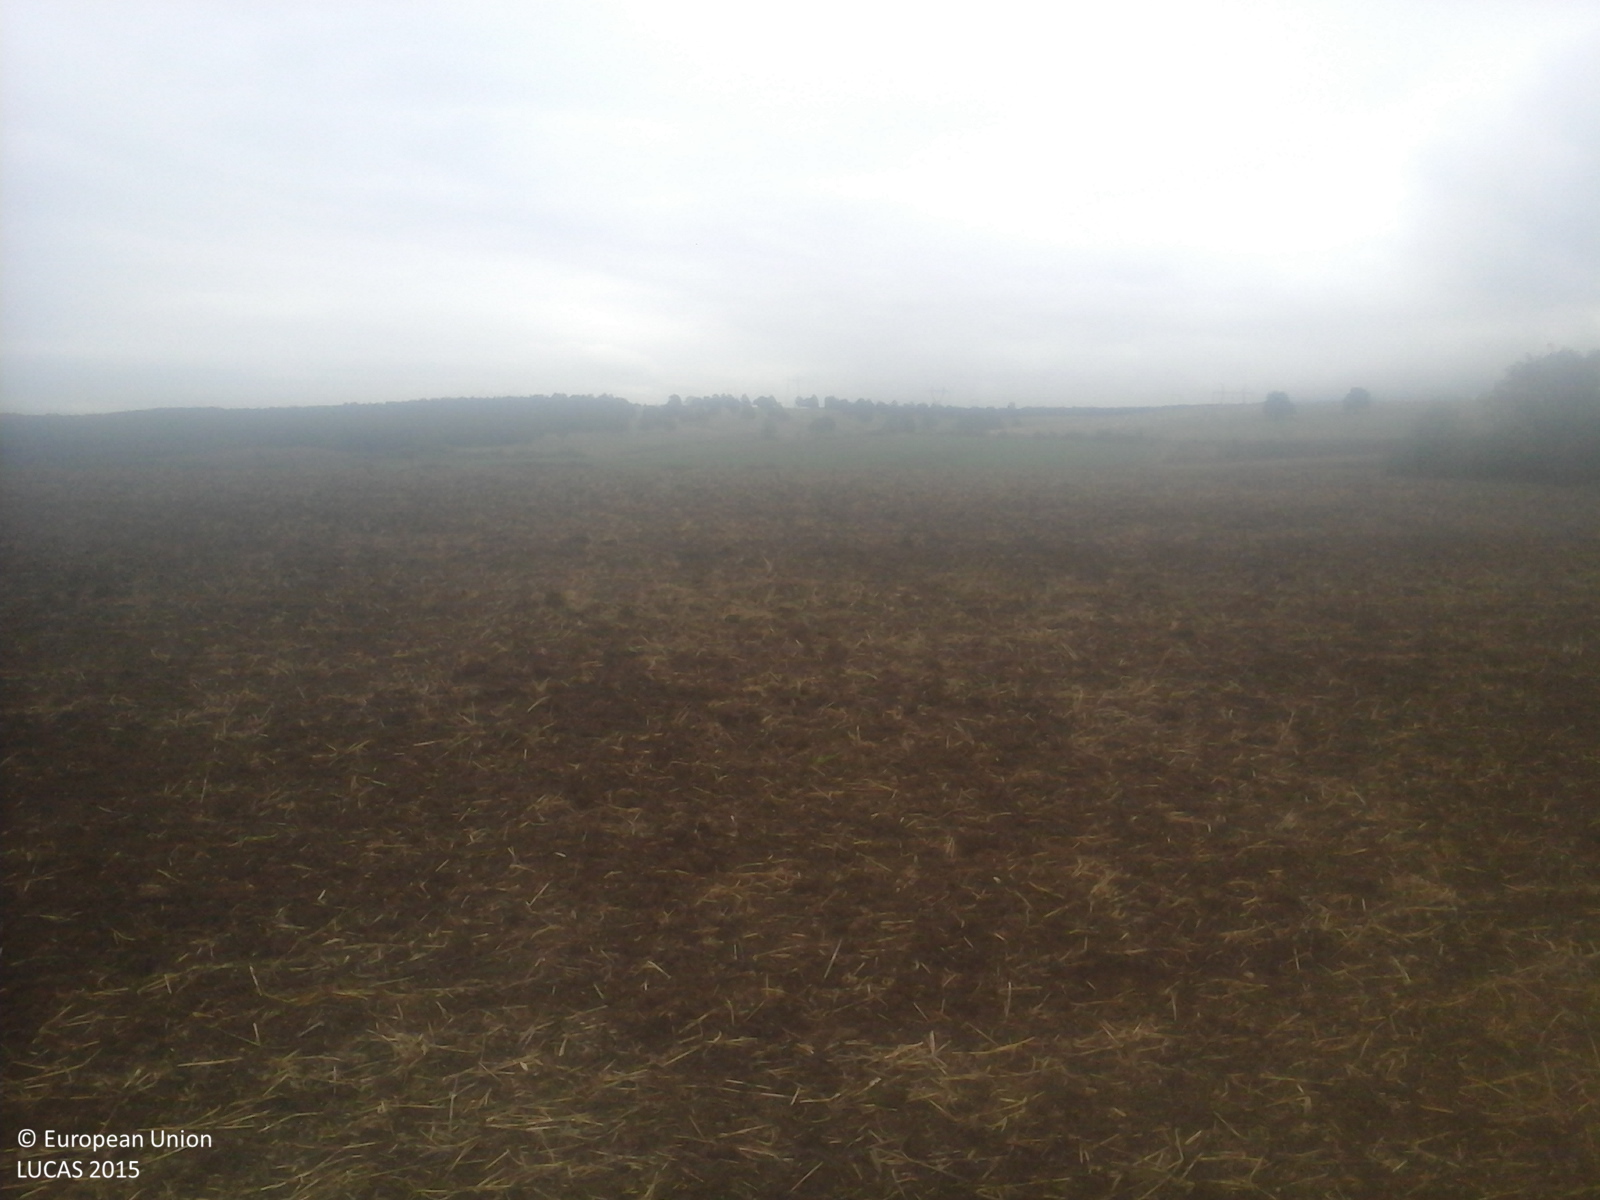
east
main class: Cropland
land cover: Common wheat
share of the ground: < 10 %
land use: Agriculture (excluding fallow land and kitchen gardens)
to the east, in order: Common wheat
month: September
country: RO
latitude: 45.9399
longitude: 23.4125
